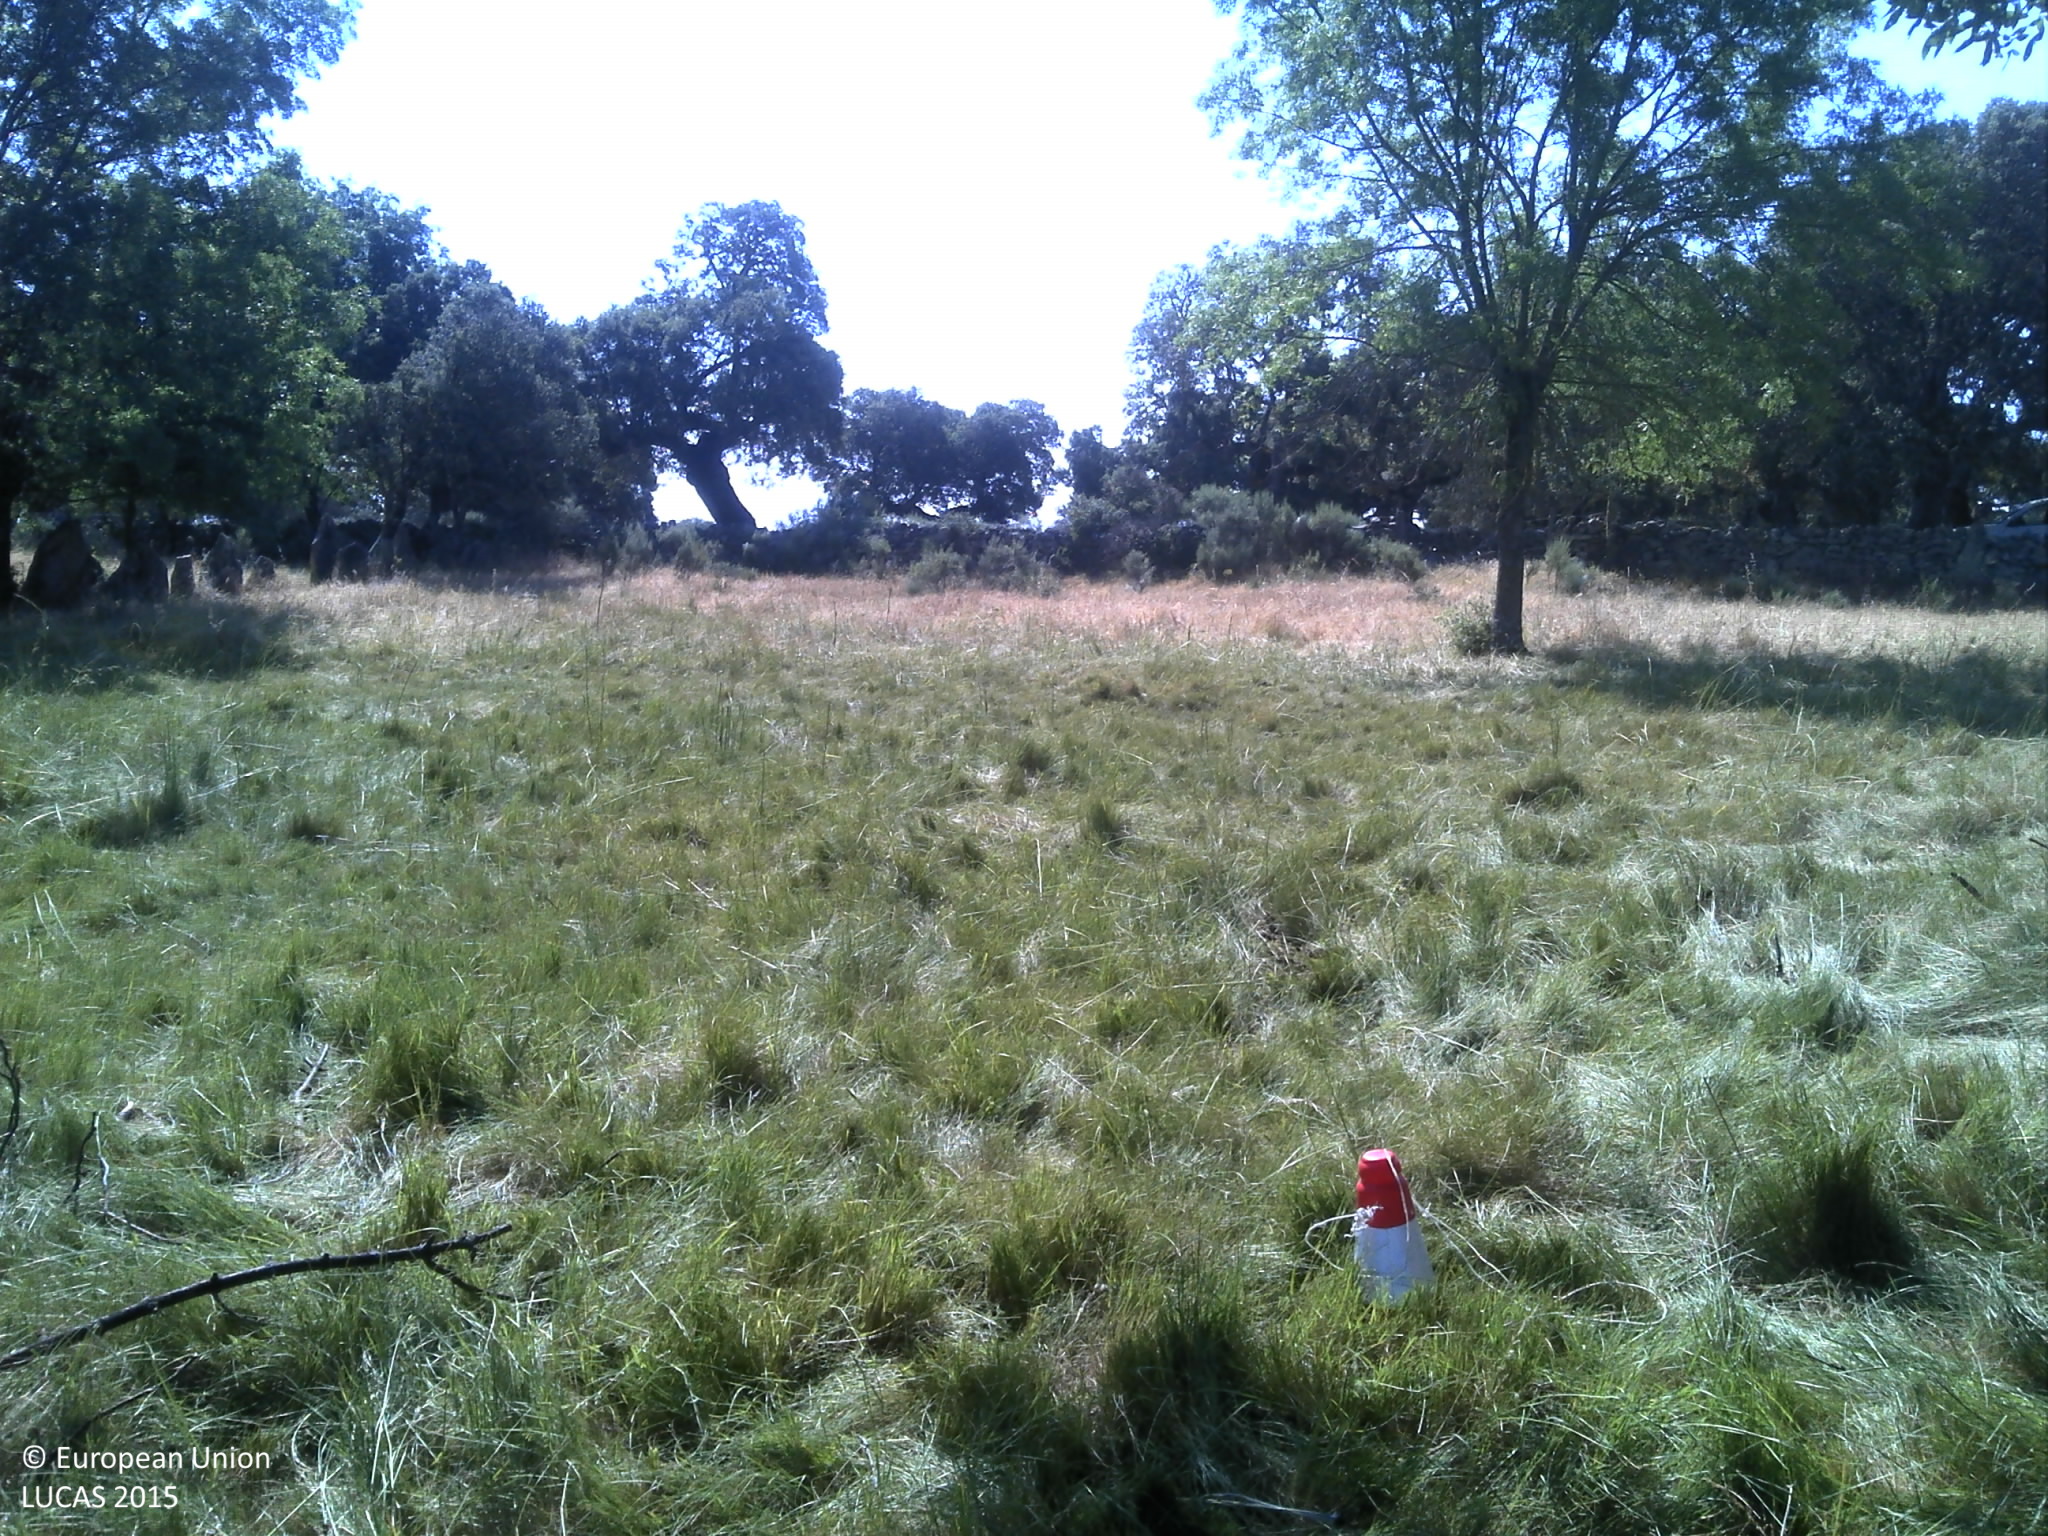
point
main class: Grassland
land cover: Grassland with sparse tree/shrub cover
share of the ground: 50 - 75 %
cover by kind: herbaceous plants 85 %, broadleaved forest trees 5 %, unconsolidated bare surface 5 %
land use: Agriculture (excluding fallow land and kitchen gardens)
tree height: > 5 m
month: June
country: PT
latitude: 40.5526
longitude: -6.8291
